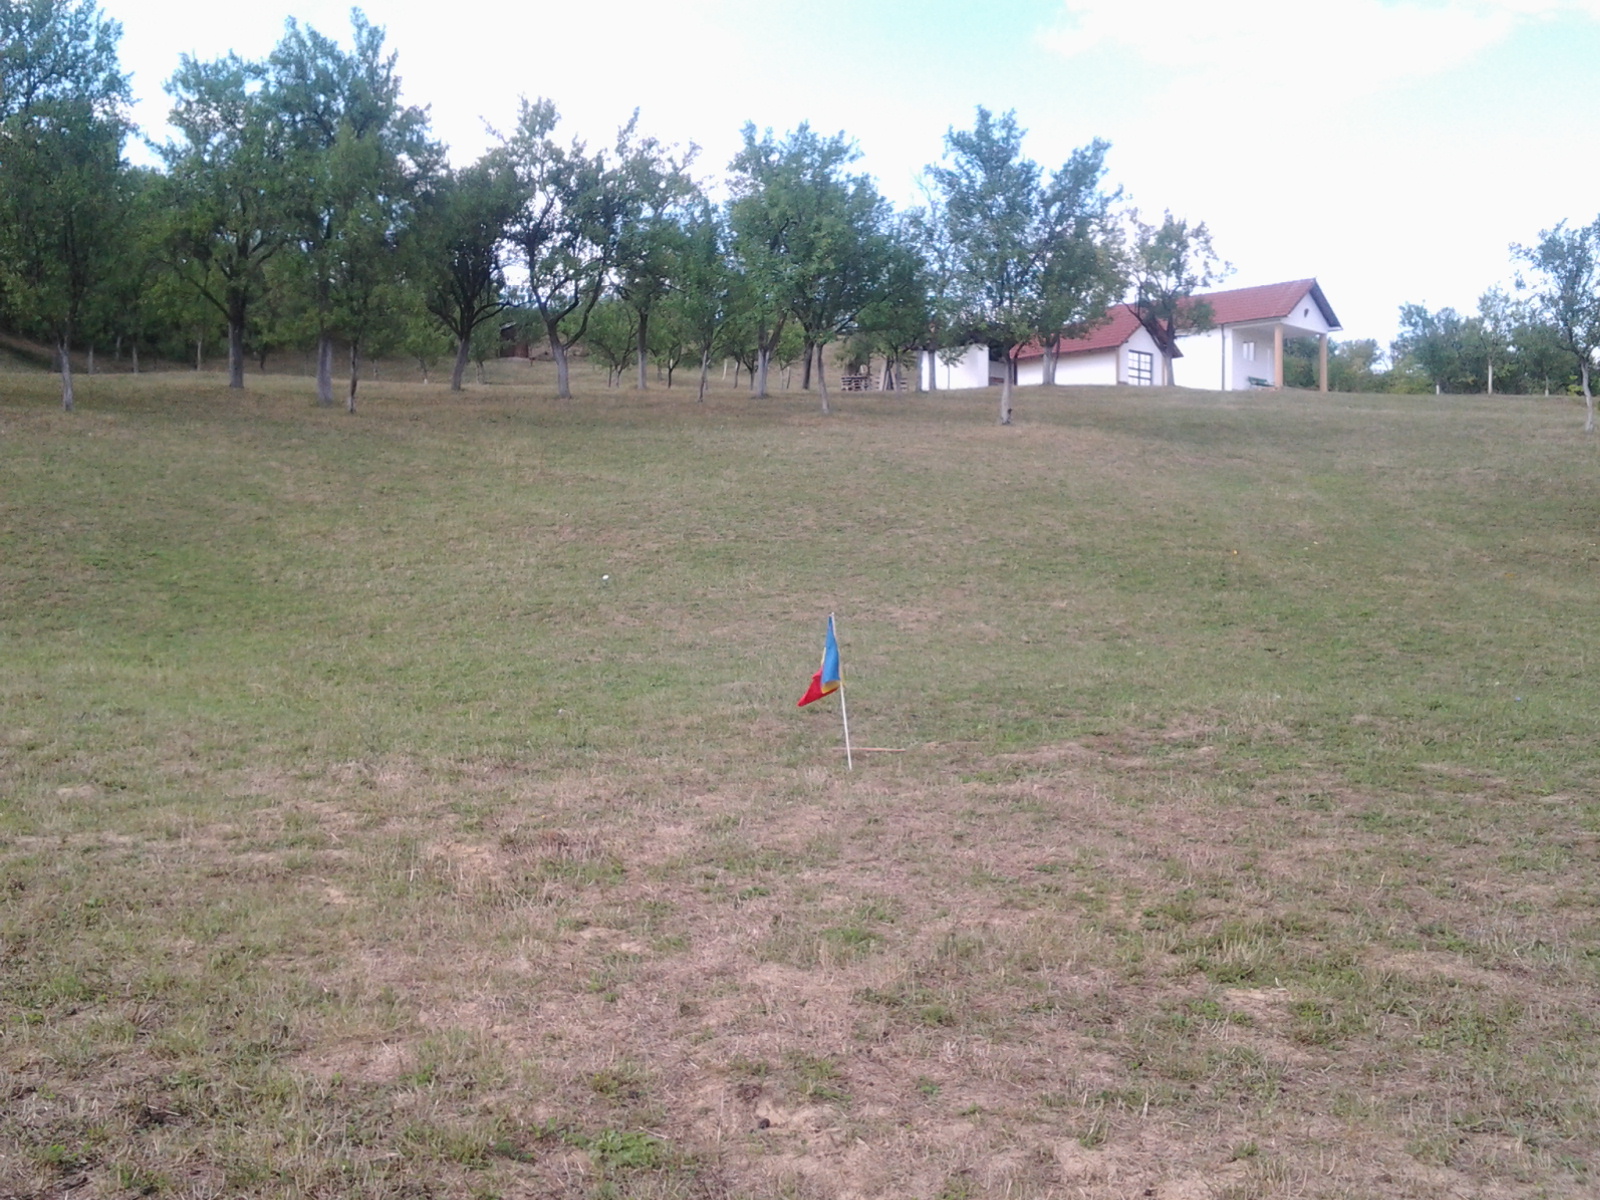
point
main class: Grassland
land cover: Grassland without tree/shrub cover
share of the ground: > 75 %
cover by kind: herbaceous plants 100 %
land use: Agriculture (excluding fallow land and kitchen gardens)
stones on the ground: < 10 %
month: September
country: RO
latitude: 47.9340
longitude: 23.3657
